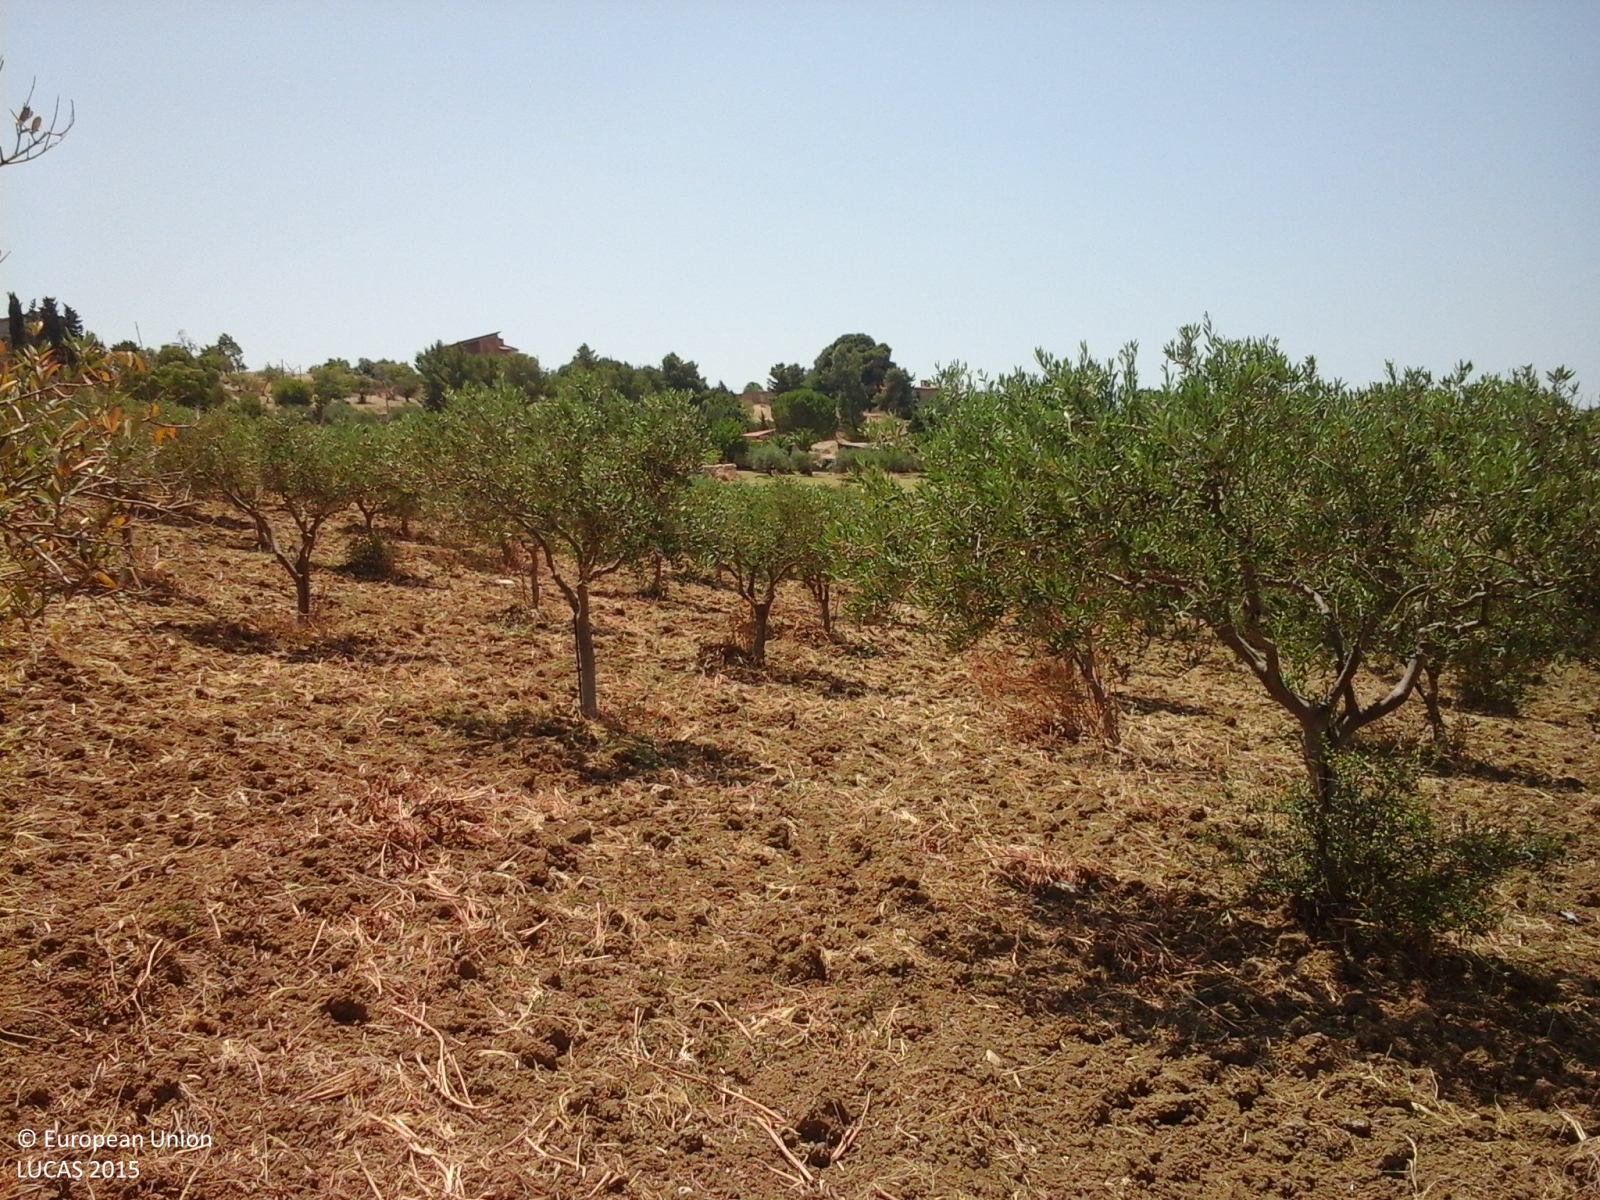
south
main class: Cropland
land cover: Olive groves
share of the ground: 25 - 50 %
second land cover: Other bare soil
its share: > 75 %
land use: Agriculture (excluding fallow land and kitchen gardens)
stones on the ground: < 10 %
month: July
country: IT
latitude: 37.4267
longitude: 13.5549
